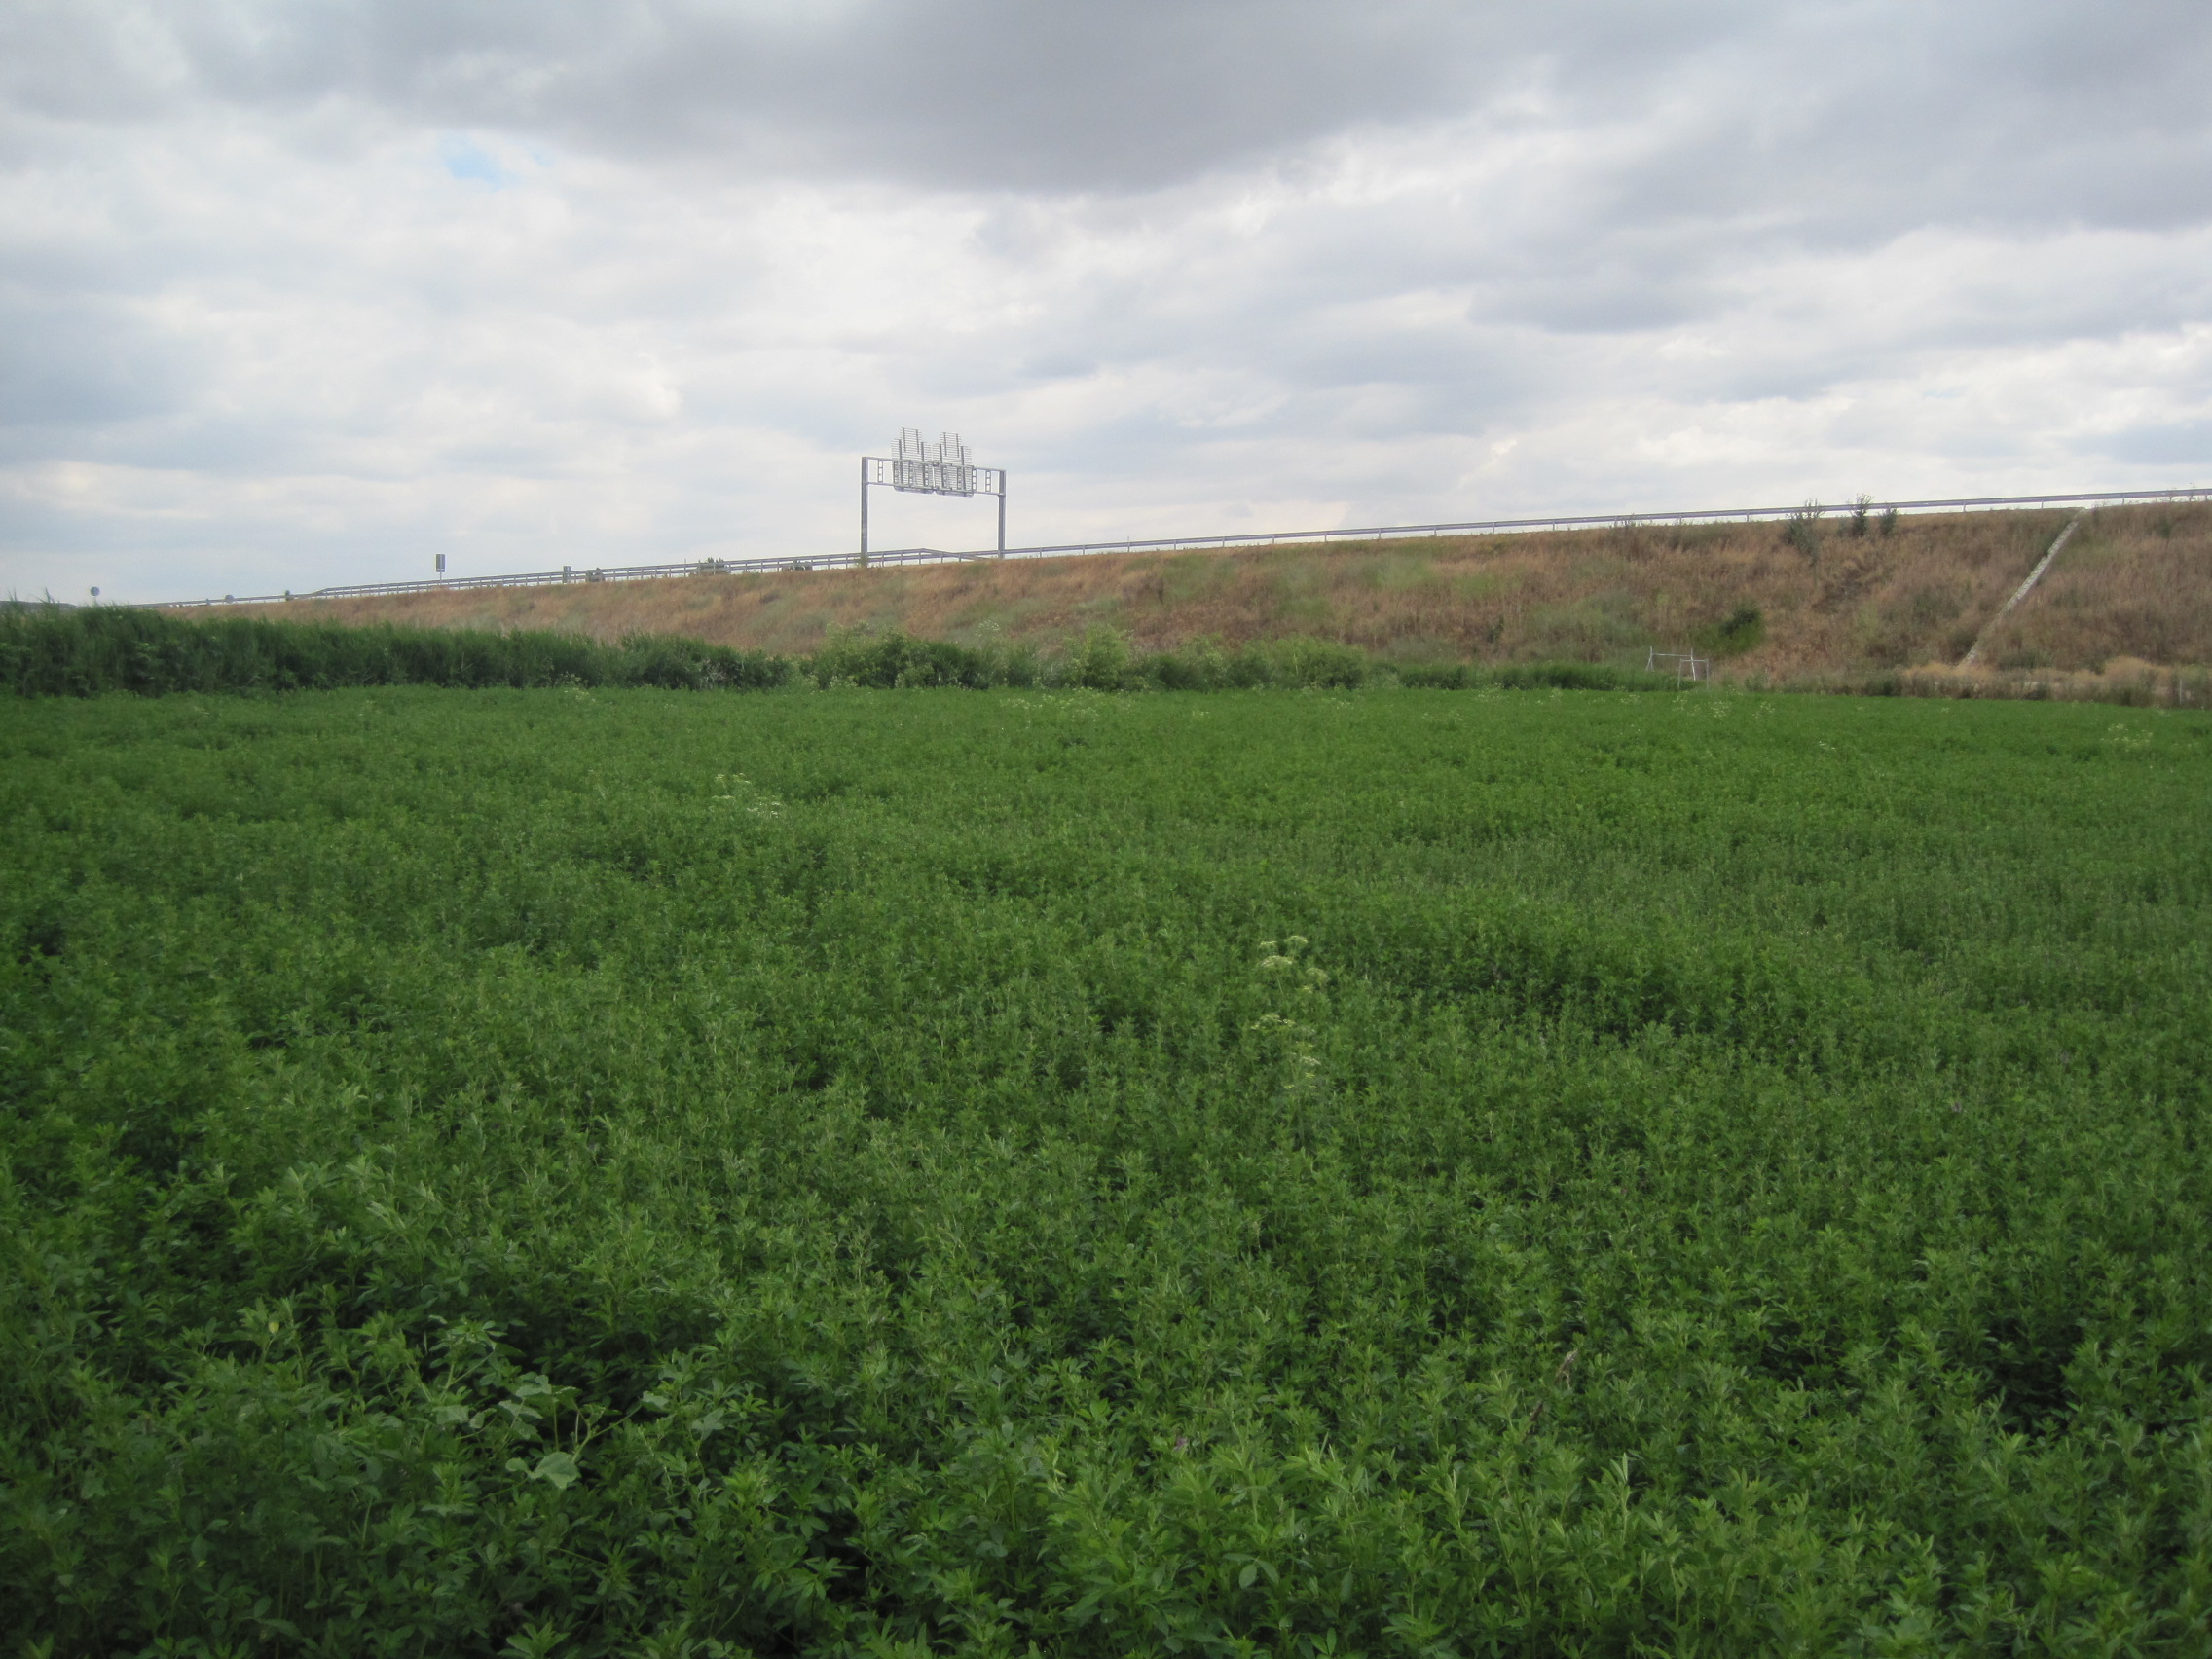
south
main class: Cropland
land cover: Lucerne
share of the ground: > 75 %
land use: Agriculture (excluding fallow land and kitchen gardens)
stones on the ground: 10 - 25 %
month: June
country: ES
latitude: 41.7251
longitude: -4.6749
